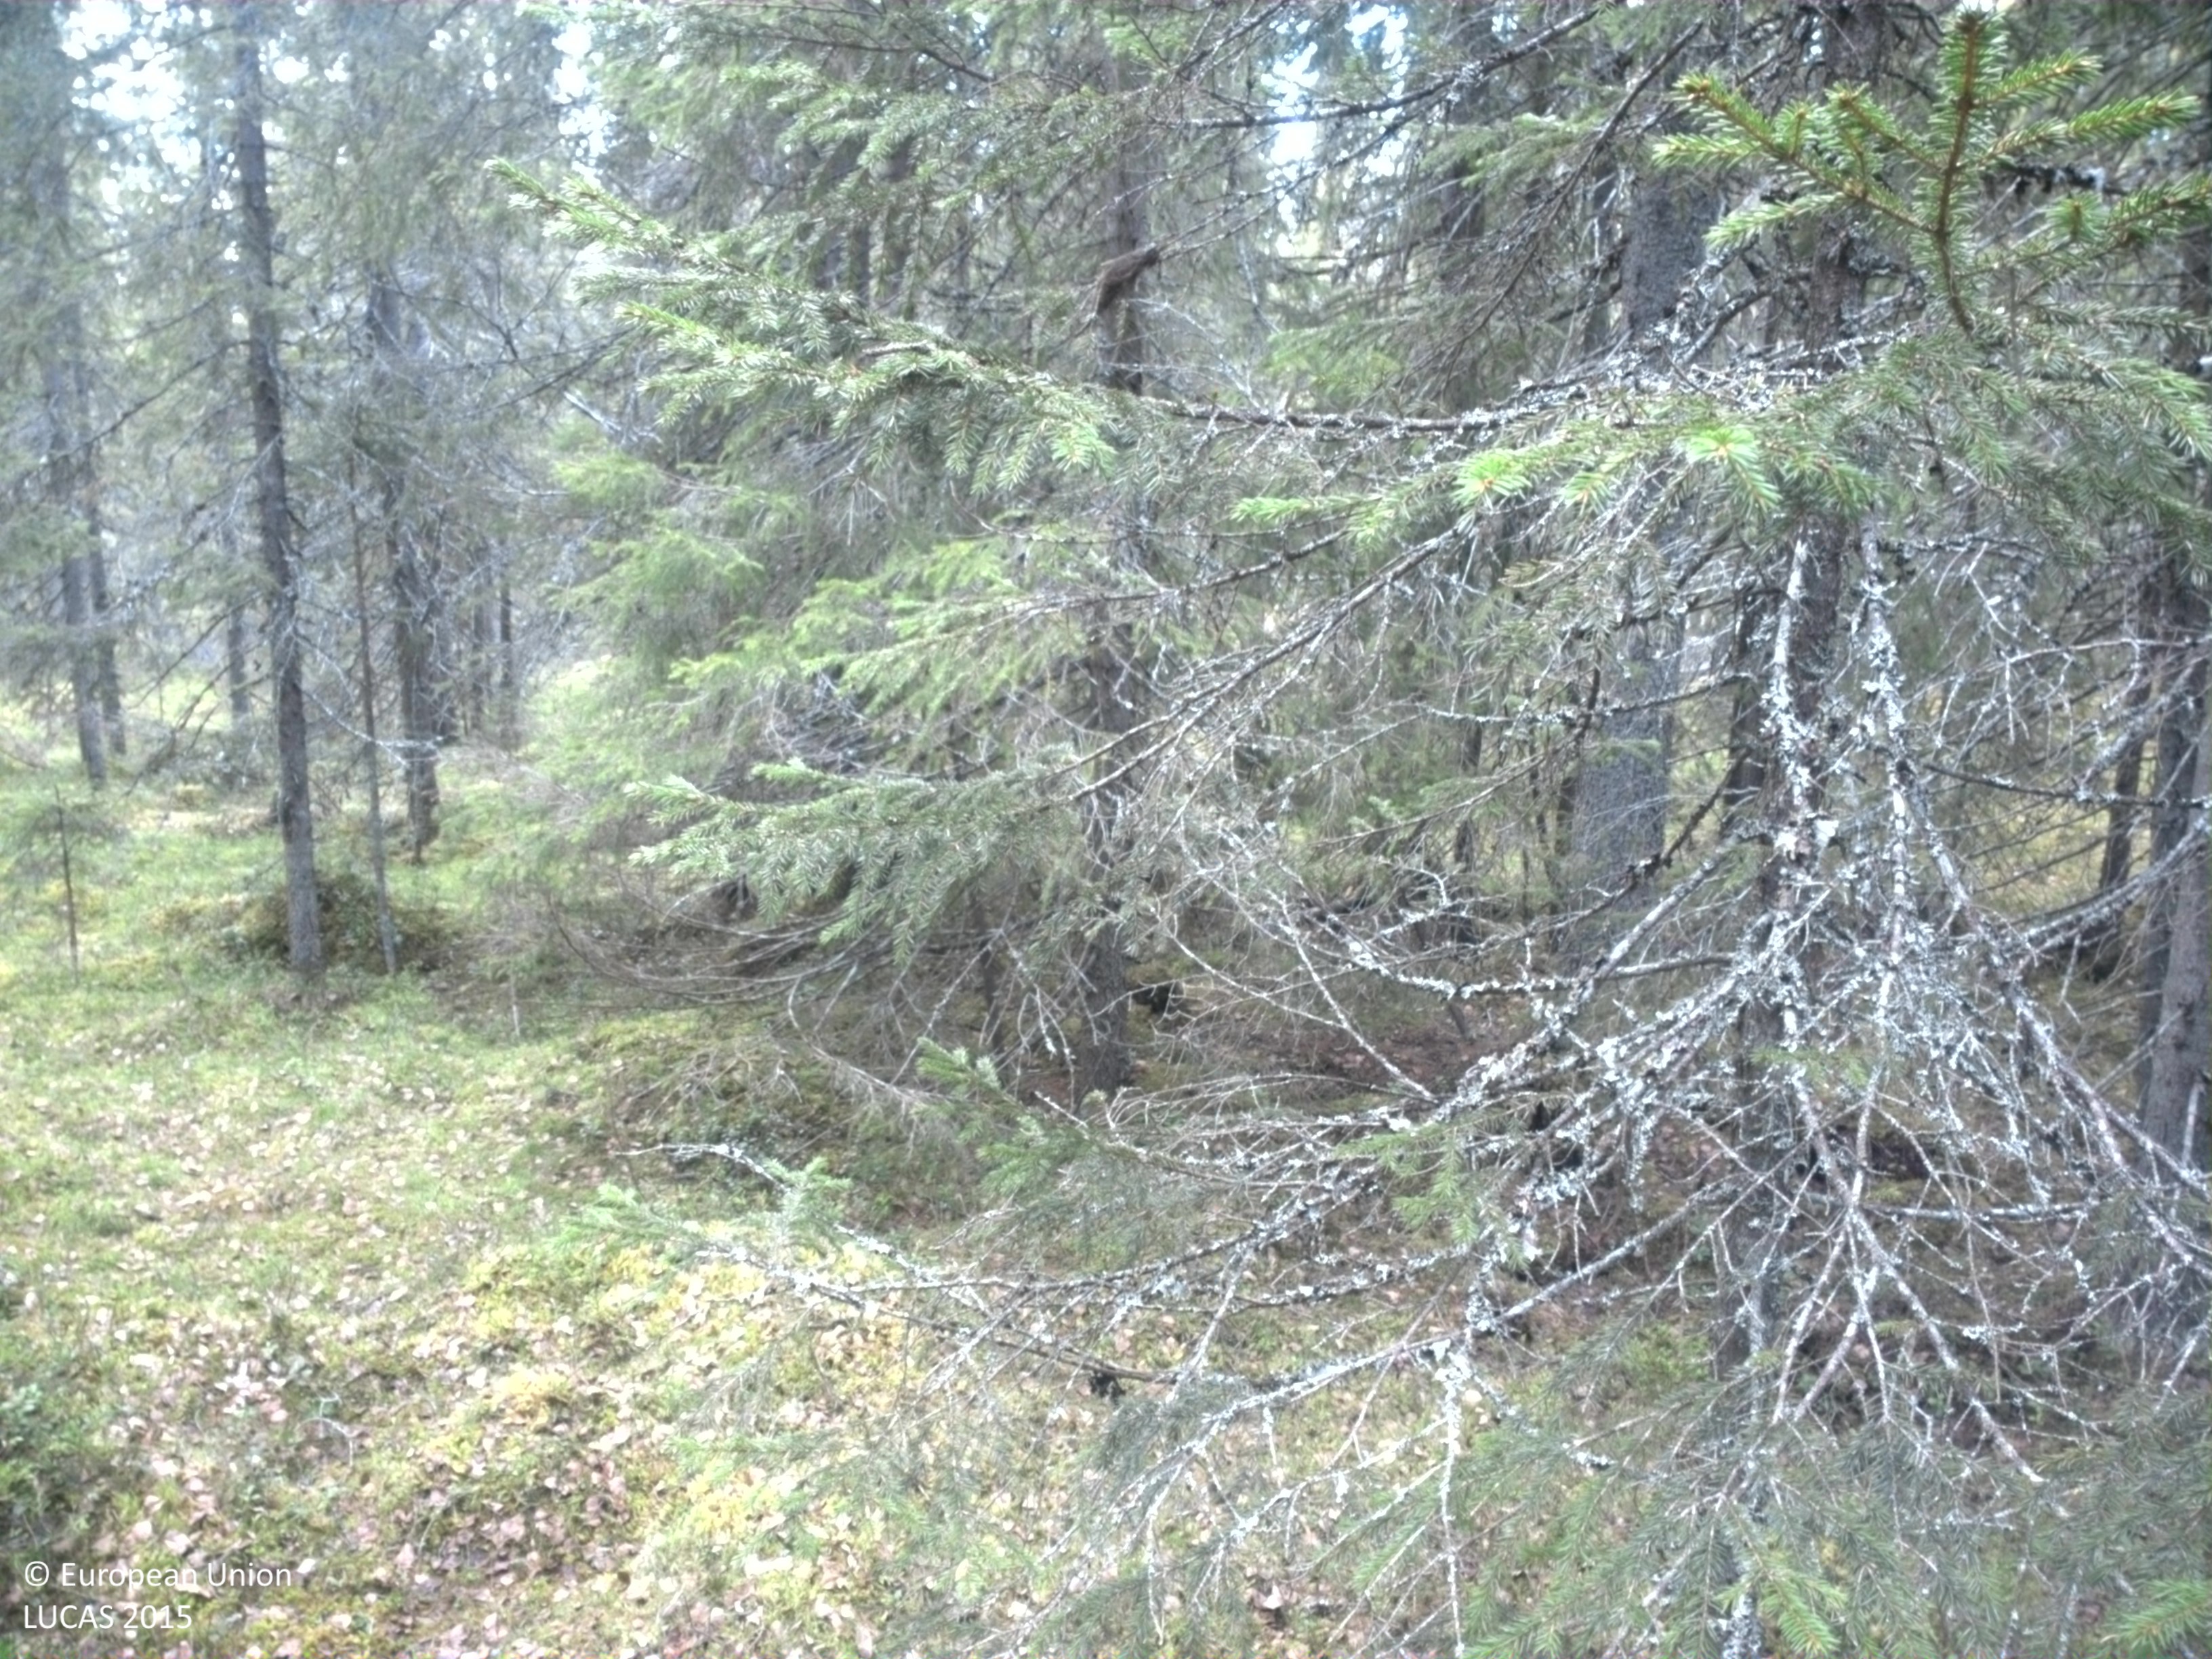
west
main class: Woodland
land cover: Spruce dominated mixed woodland
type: boreal forest
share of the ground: > 75 %
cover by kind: coniferous forest trees 60 %, broadleaved forest trees 20 %, shrubs 10 %, lichens and mosses 10 %
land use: Forestry
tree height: > 5 m
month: June
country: SE
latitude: 63.5179
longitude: 13.9396
